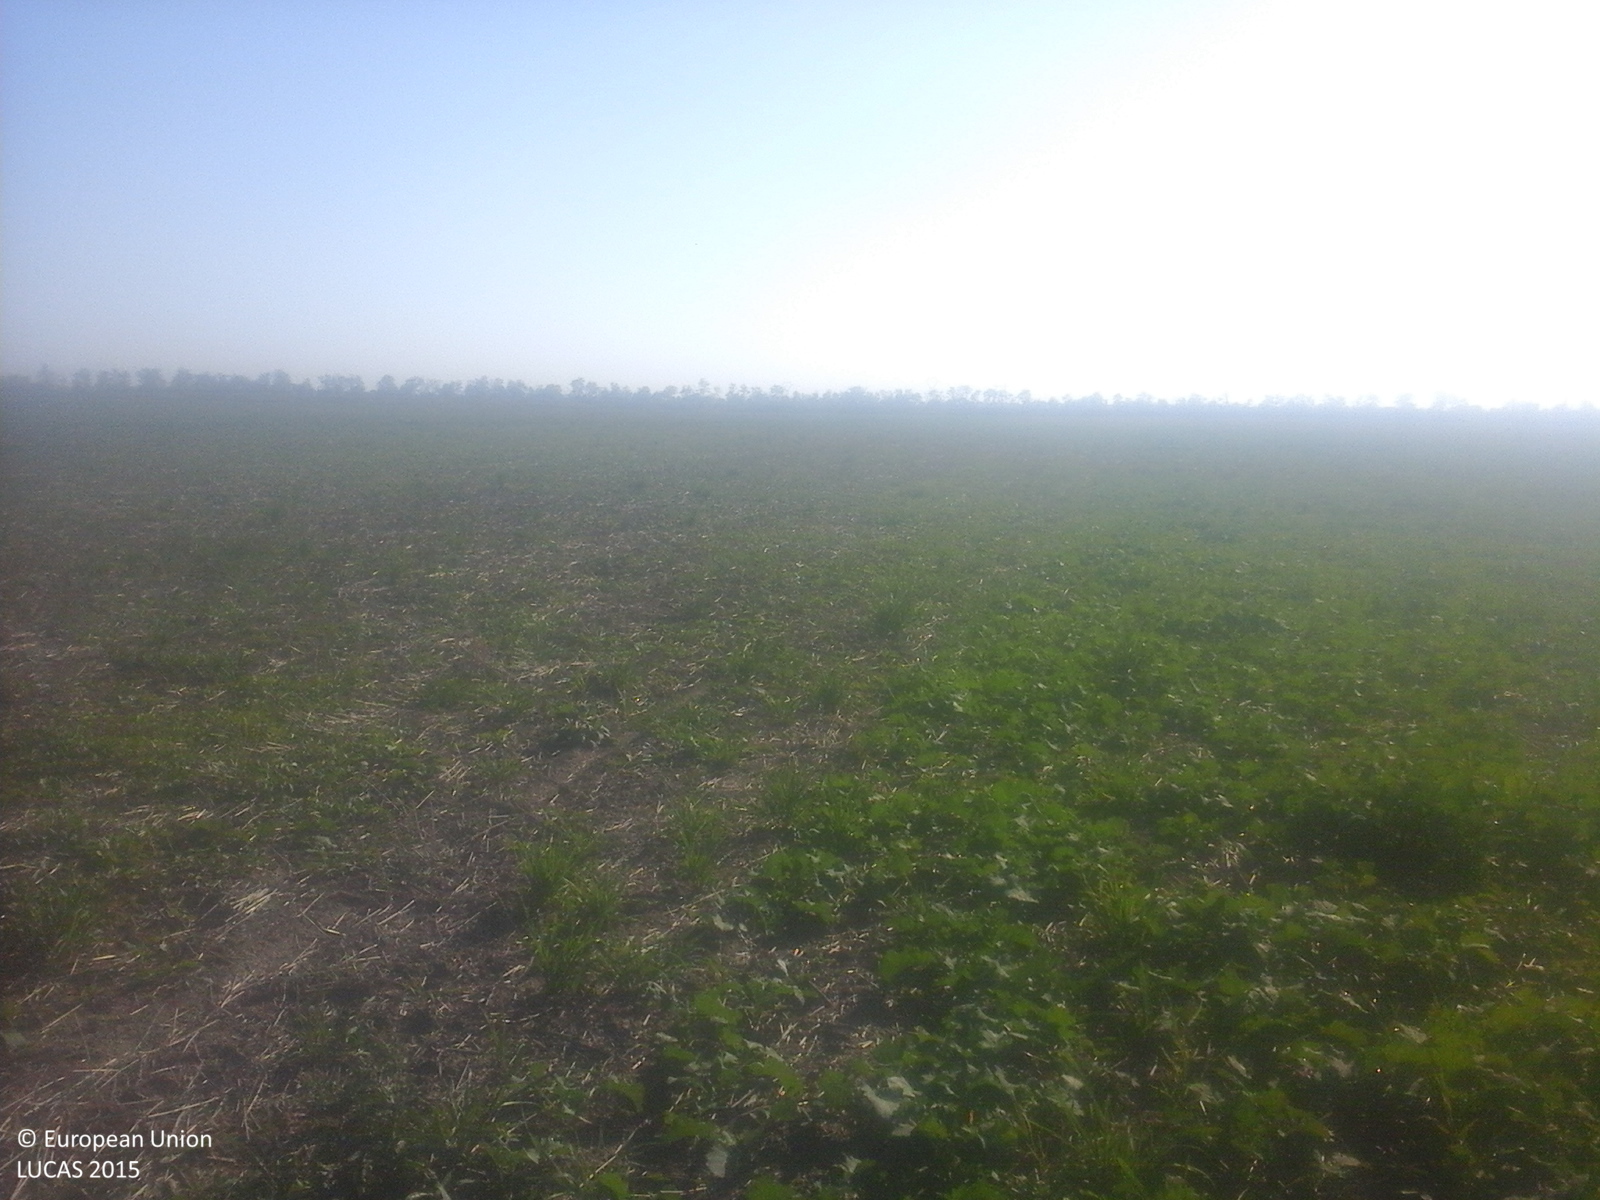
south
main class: Cropland
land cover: Sugar beet
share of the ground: 50 - 75 %
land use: Agriculture (excluding fallow land and kitchen gardens)
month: October
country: RO
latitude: 45.8403
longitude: 27.2347
